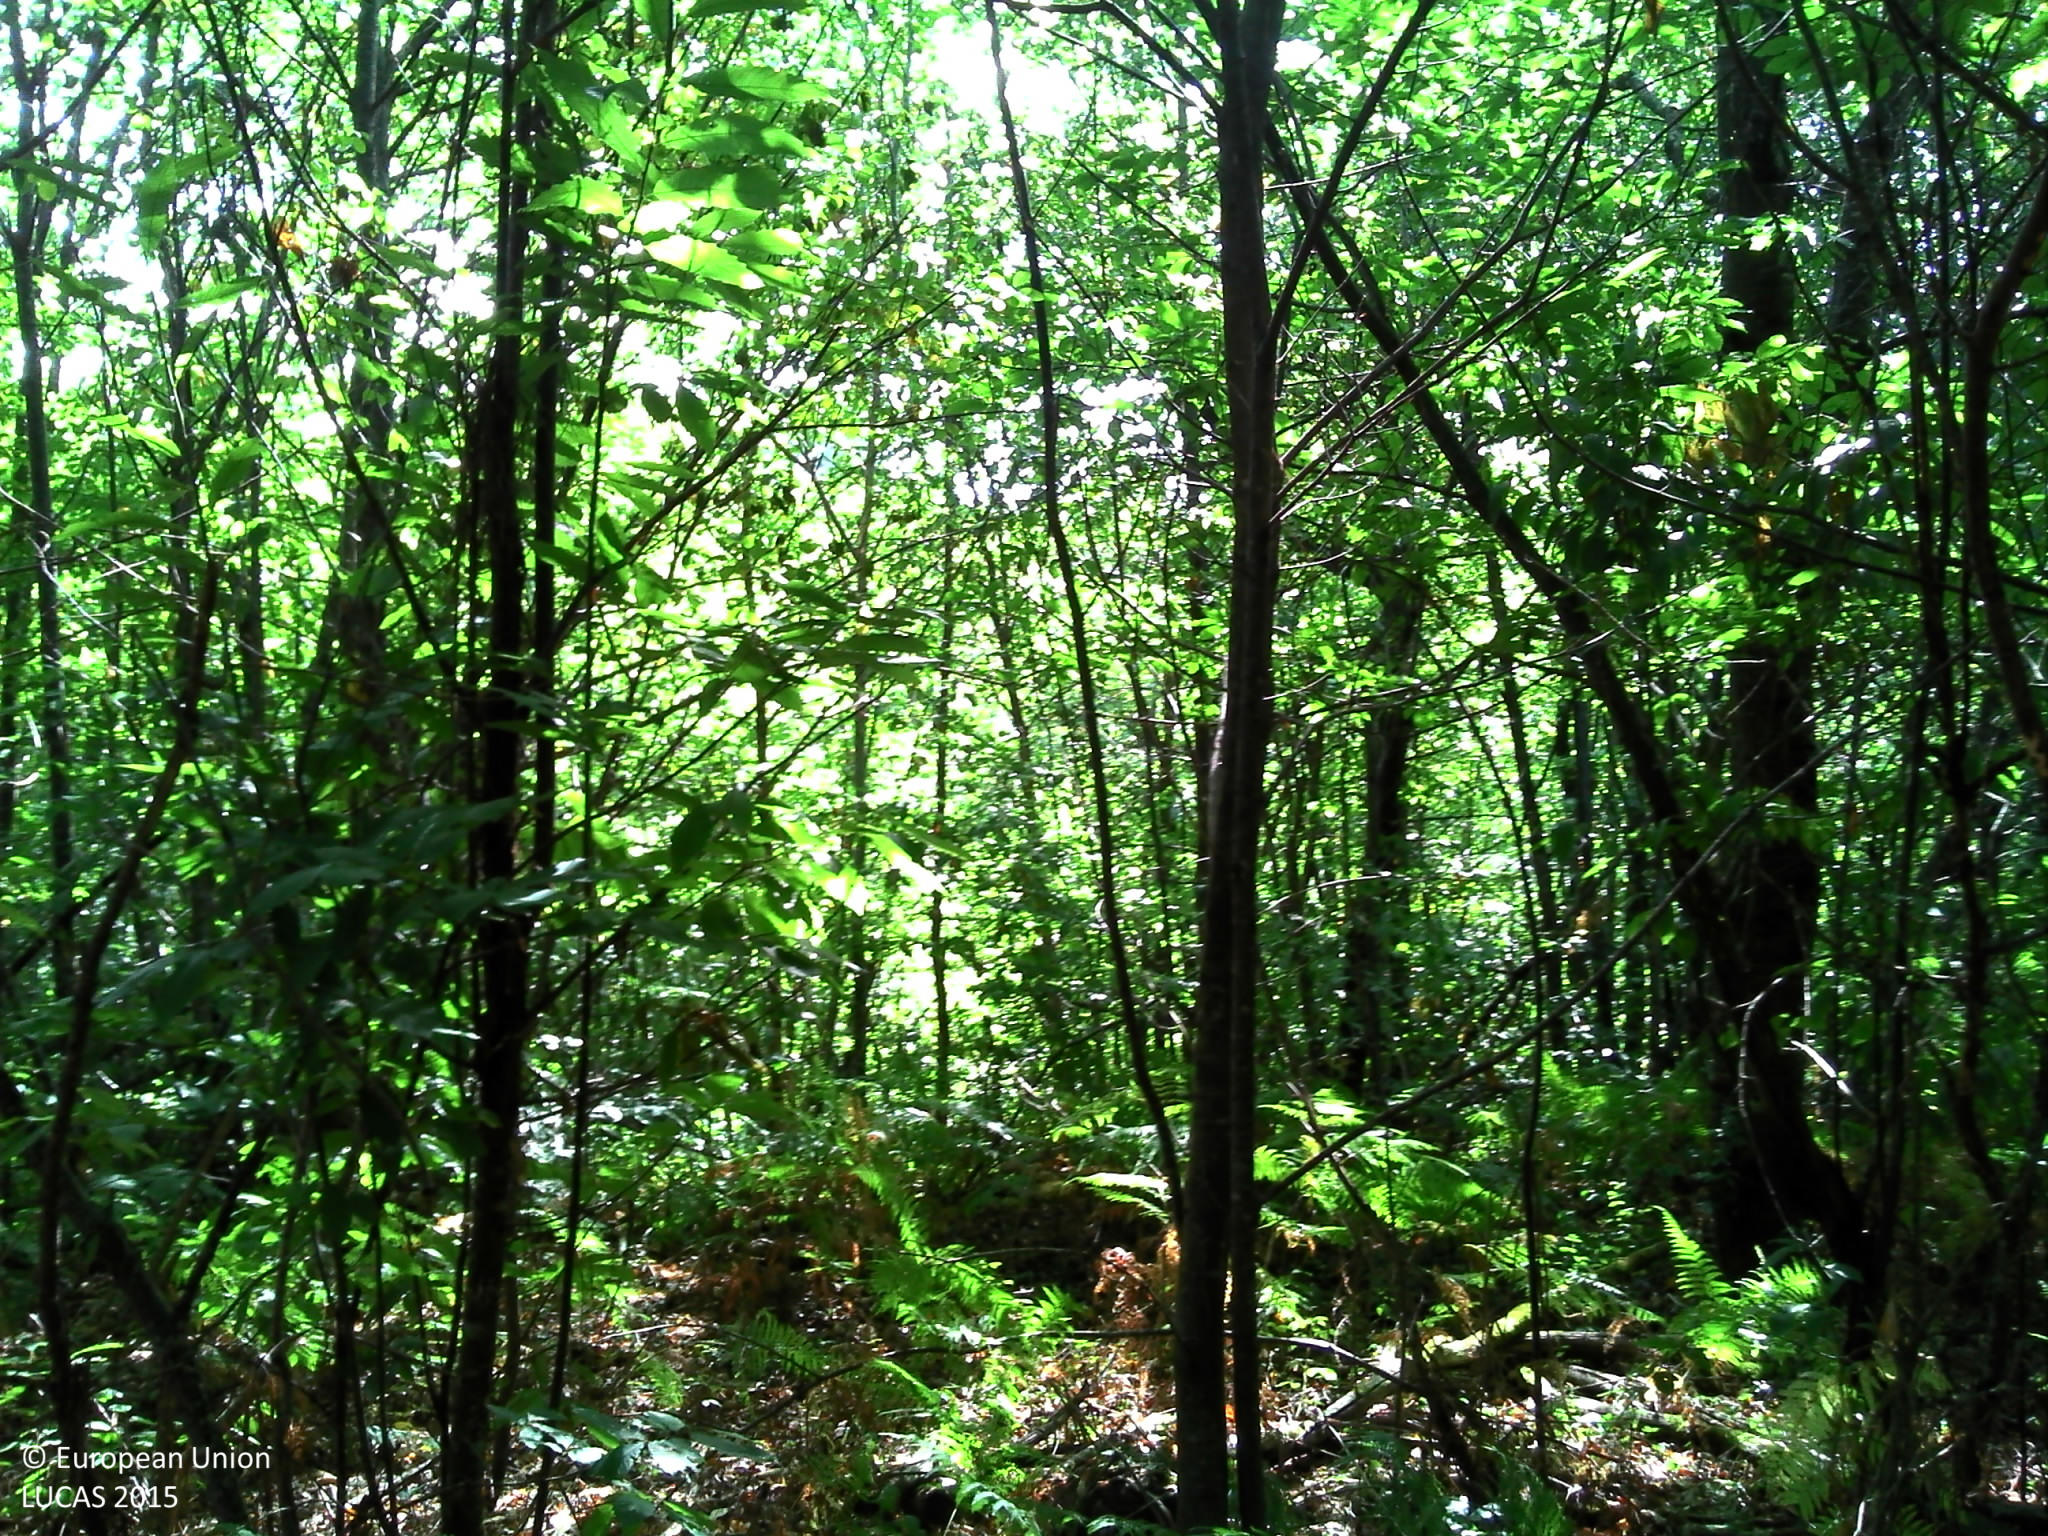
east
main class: Woodland
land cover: Broadleaved woodland
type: thermophilous deciduous forest
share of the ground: > 75 %
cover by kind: broadleaved forest trees 80 %, herbaceous plants 10 %, shrubs 5 %, lichens and mosses 5 %
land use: Forestry
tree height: > 5 m
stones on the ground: > 50 %
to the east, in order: Broadleaved woodland; Tracks; Broadleaved woodland; Grass margins; Other bare soil
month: July
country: FR
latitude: 44.9917
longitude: 1.2042
